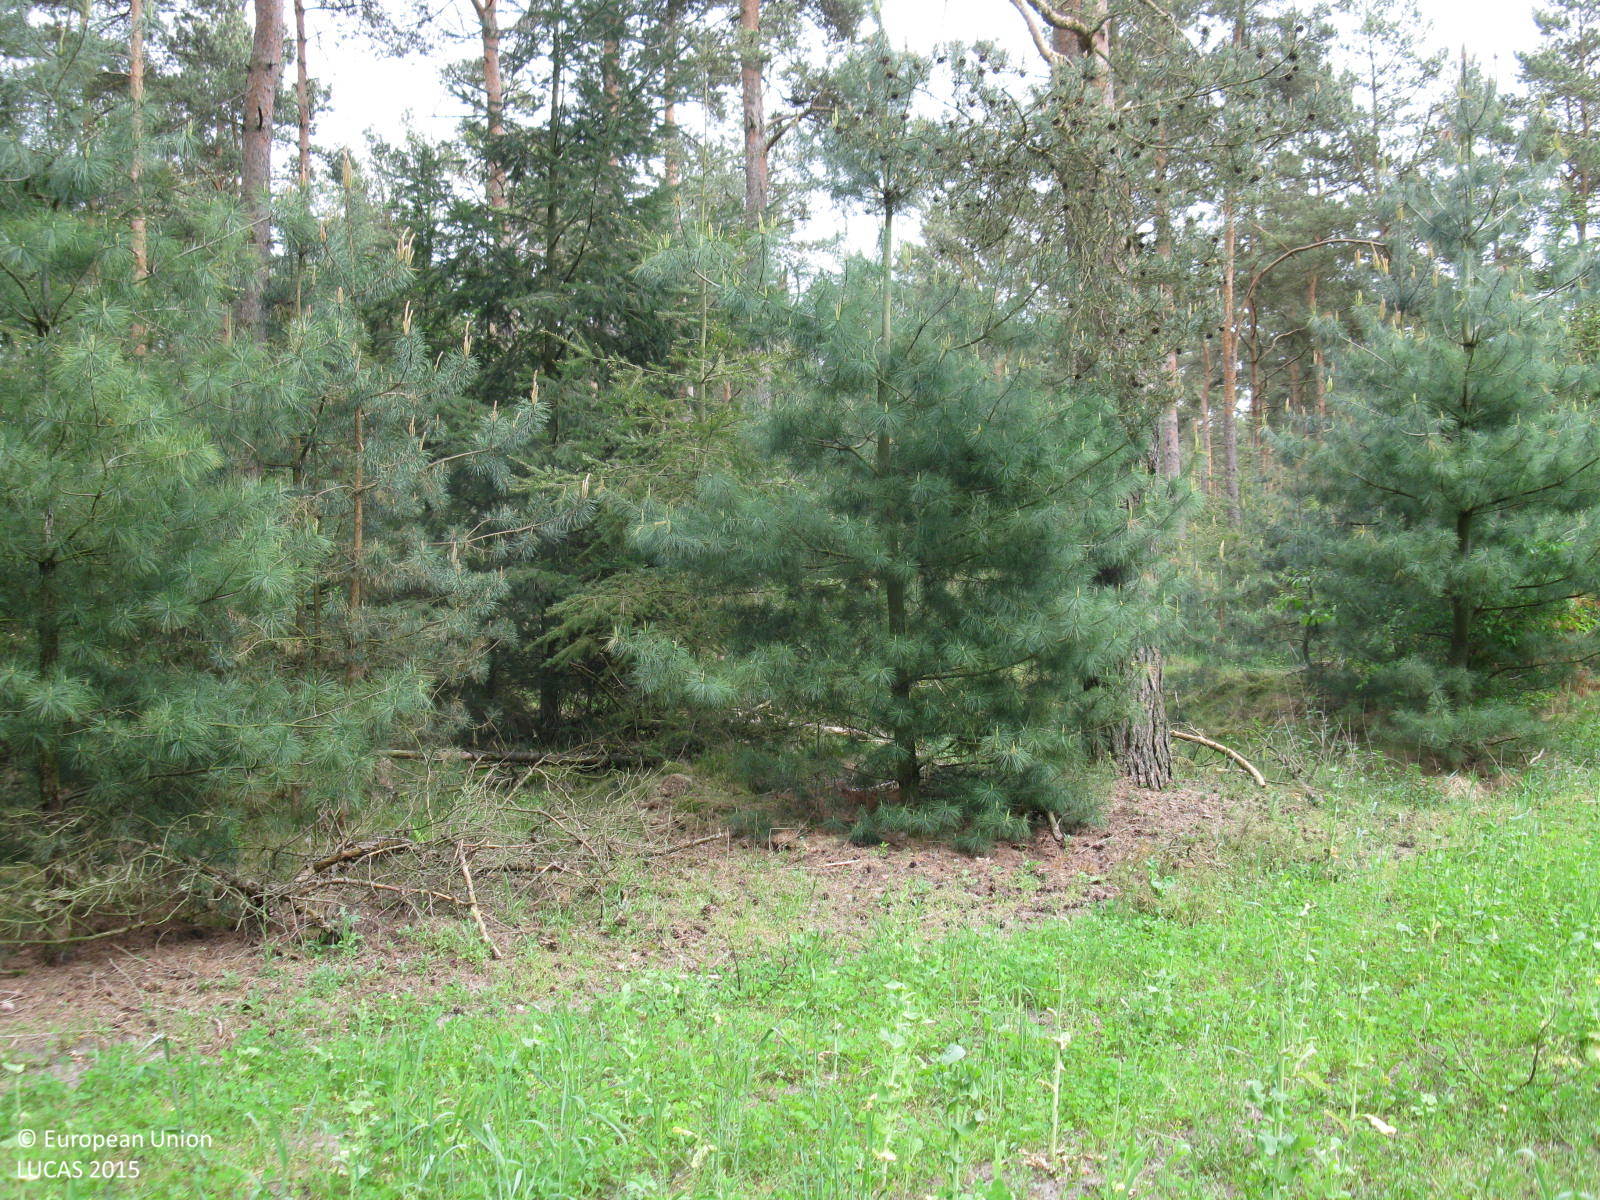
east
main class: Woodland
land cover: Pine dominated coniferous woodland
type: hemiboreal forest and nemoral coniferous forest and mixed broadleaved-coniferous forest
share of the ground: 50 - 75 %
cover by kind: coniferous forest trees 70 %, broadleaved forest trees 10 %, shrubs 10 %, herbaceous plants 10 %
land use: Forestry
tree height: > 5 m
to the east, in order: Pine dominated coniferous woodland; Fences; Spontaneously vegetated surfaces; Pine dominated coniferous woodland; Tracks; Pine dominated coniferous woodland
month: May
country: DE
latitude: 52.8333
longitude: 7.3435
